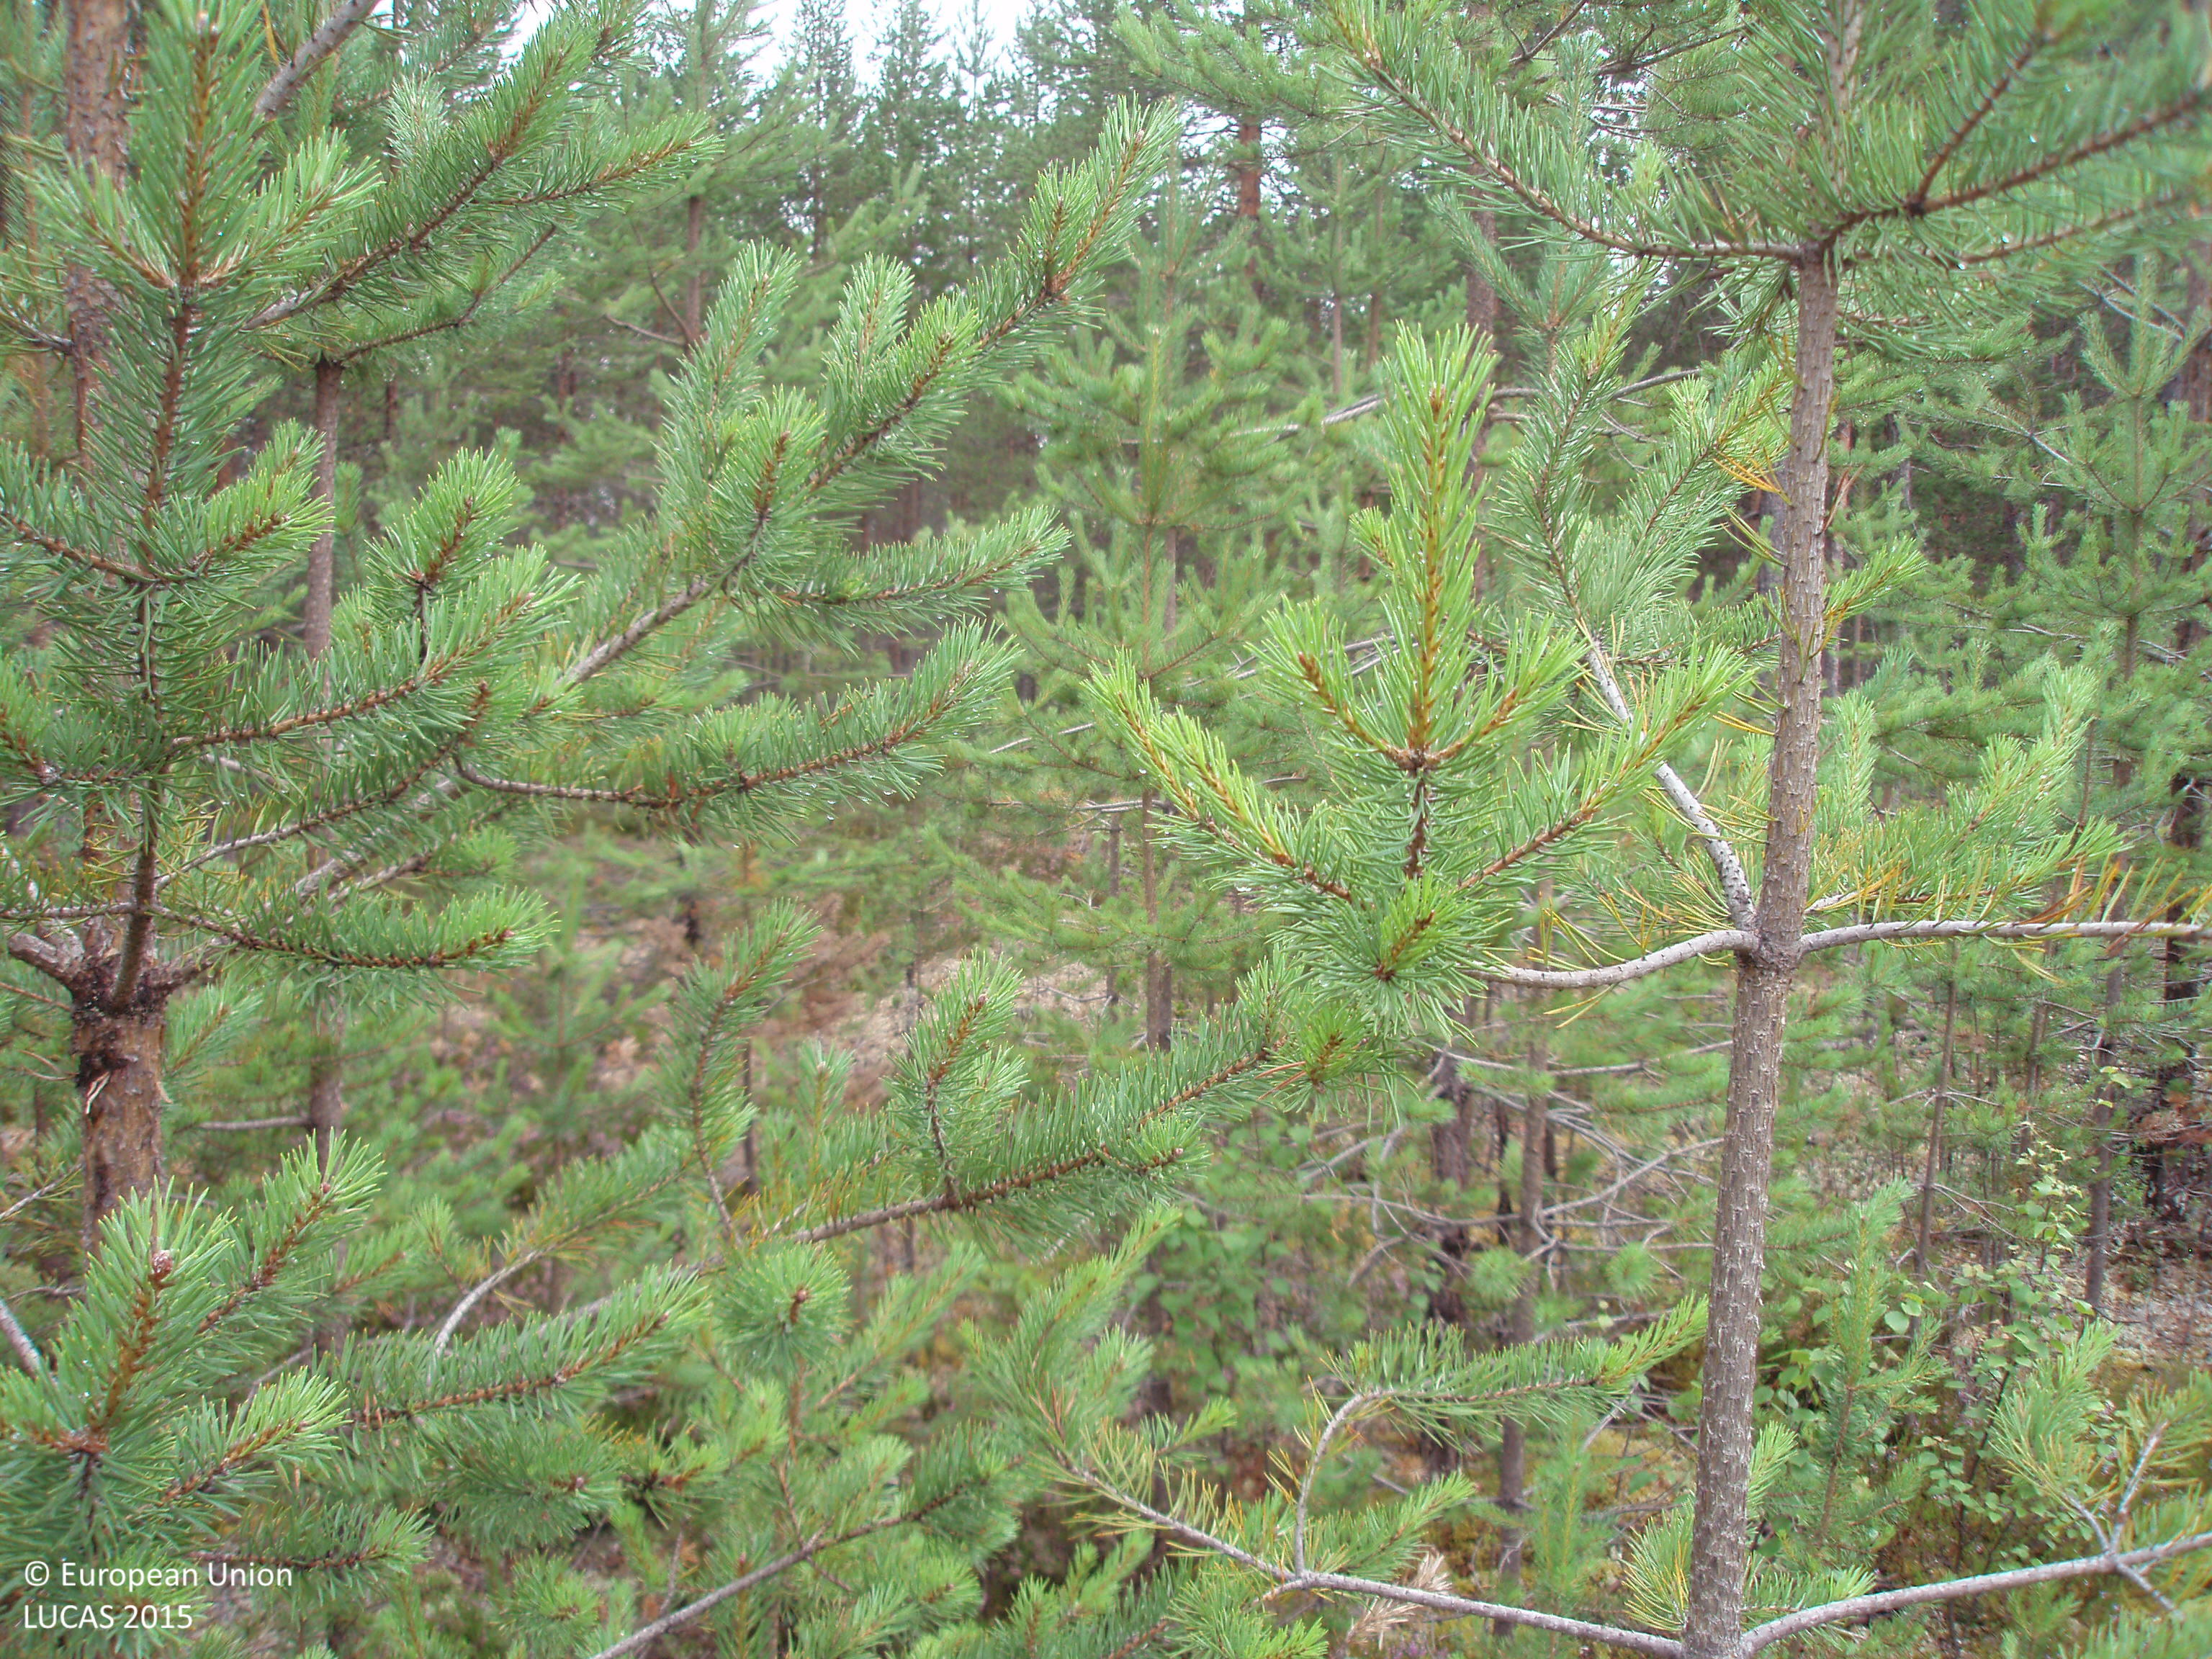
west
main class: Woodland
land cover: Pine dominated coniferous woodland
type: boreal forest
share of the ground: 25 - 50 %
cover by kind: shrubs 60 %, coniferous forest trees 40 %
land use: Forestry
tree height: < 5 m
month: August
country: FI
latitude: 65.5889
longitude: 27.0063
